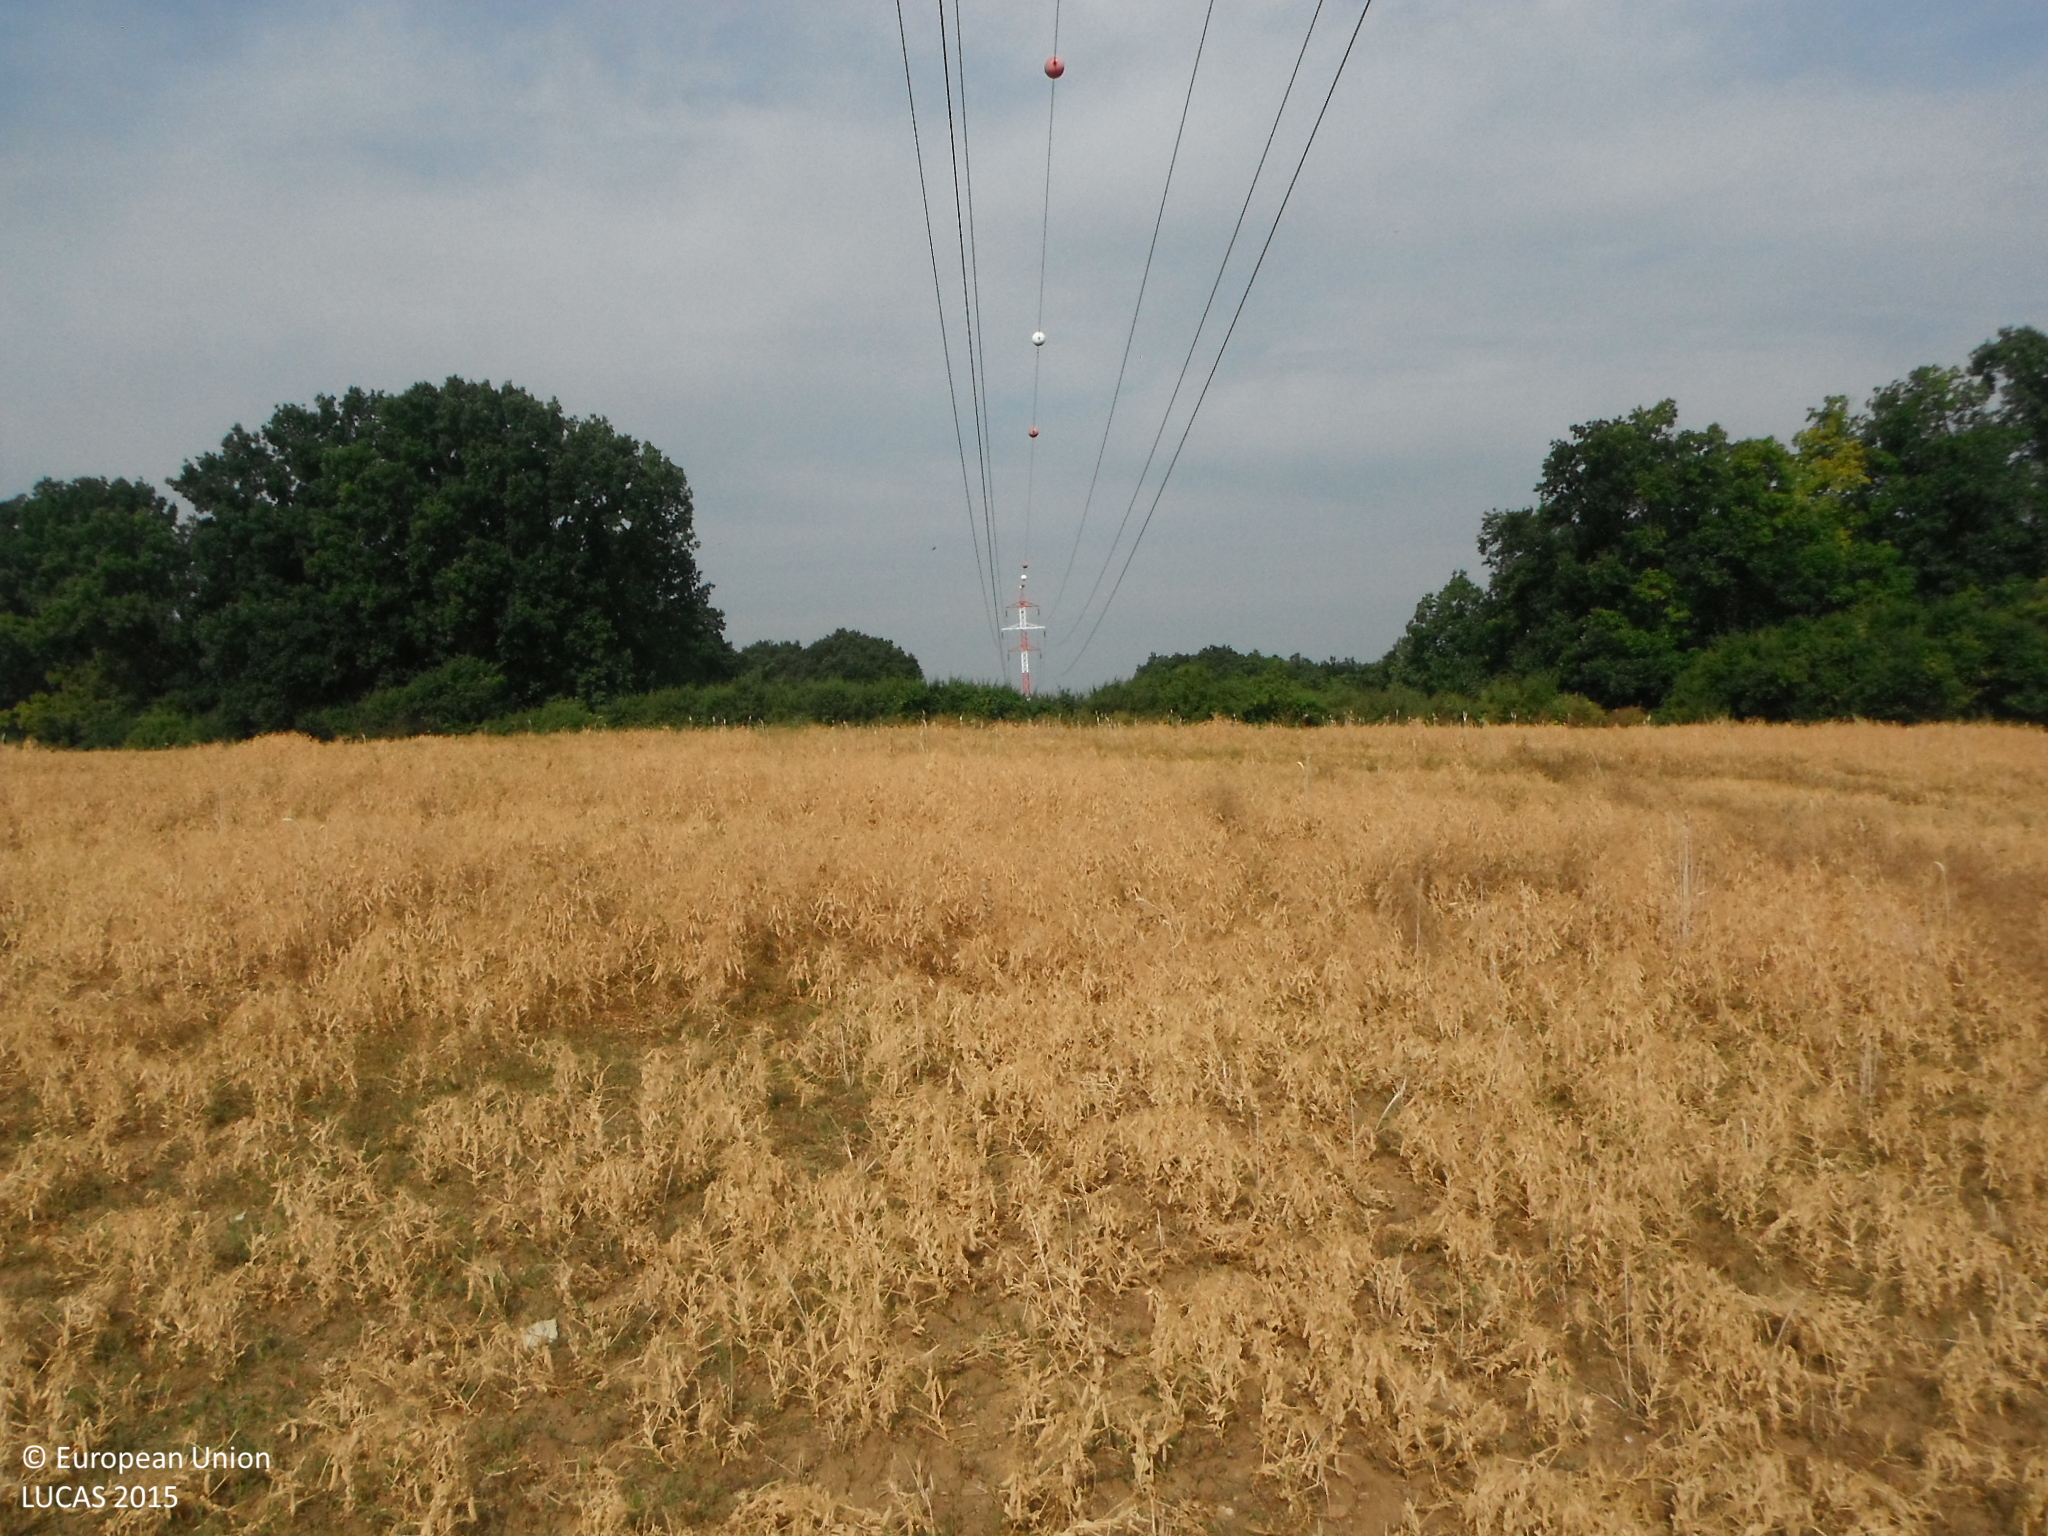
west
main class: Cropland
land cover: Dry pulses
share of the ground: > 75 %
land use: Agriculture (excluding fallow land and kitchen gardens)
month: June
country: SK
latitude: 48.3646
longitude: 17.7731
